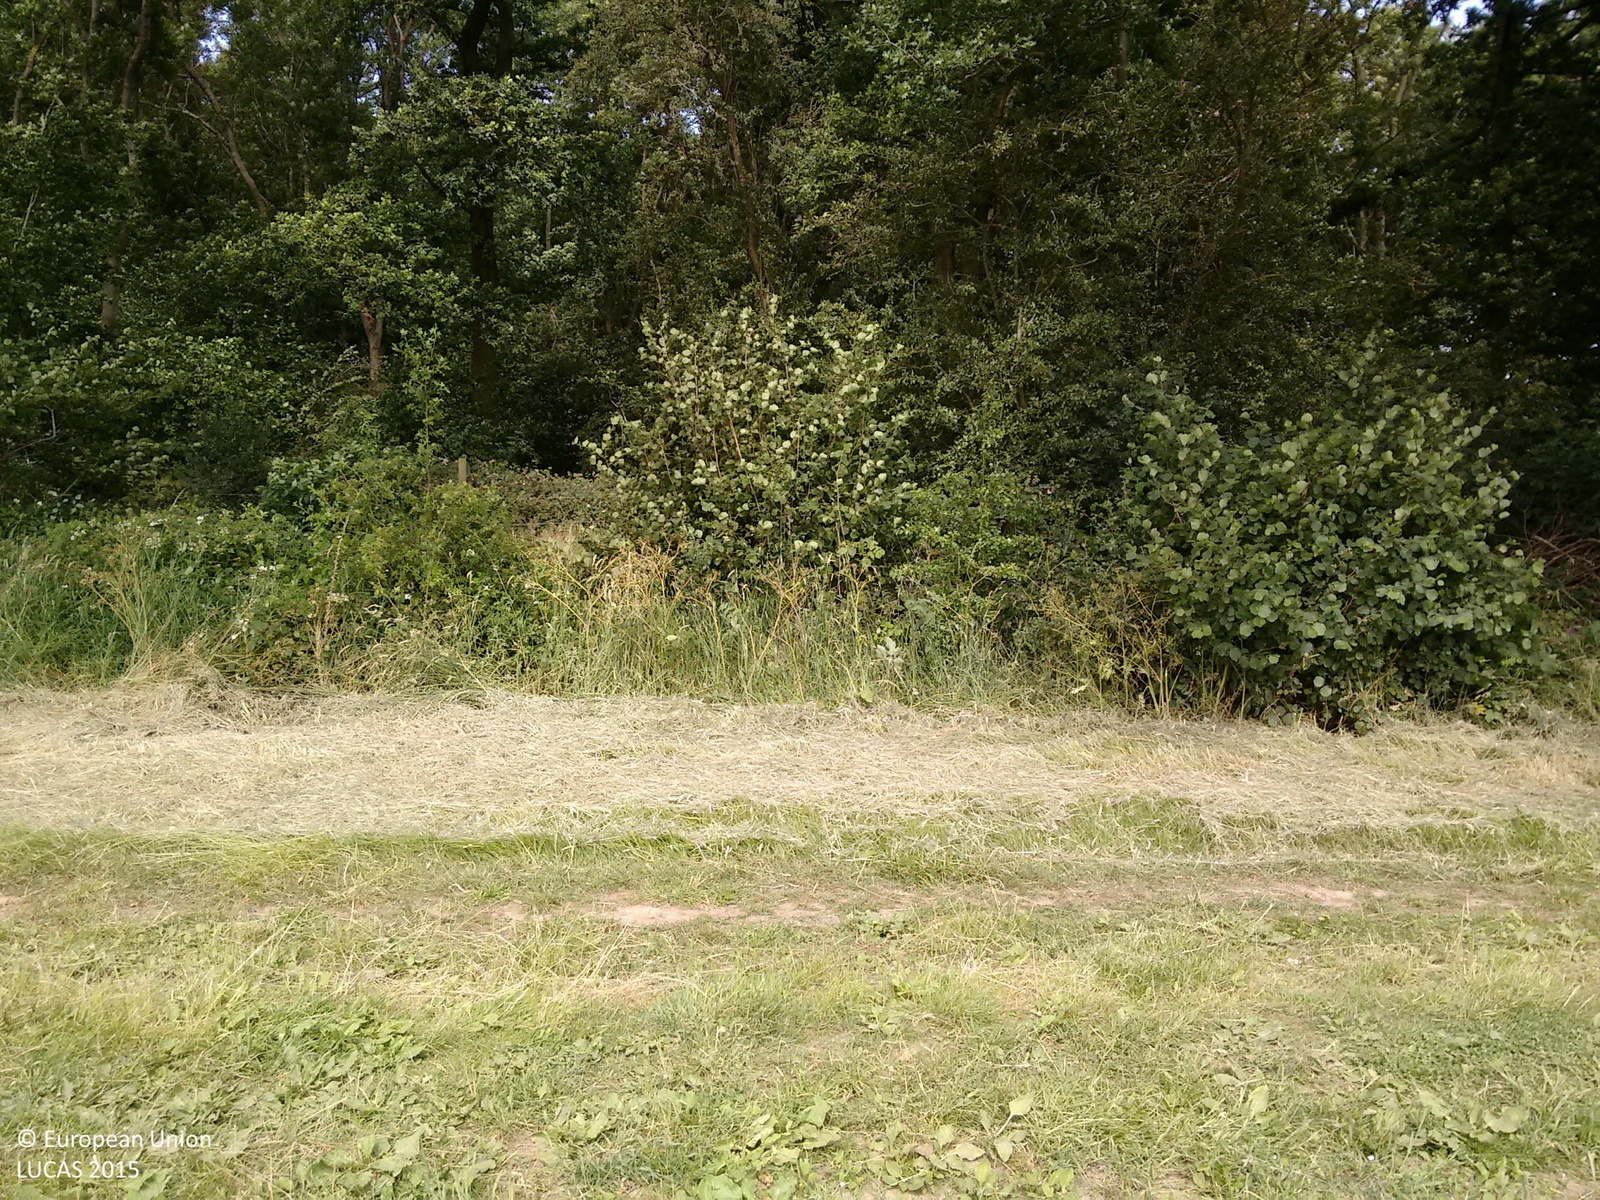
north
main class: Grassland
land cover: Grassland without tree/shrub cover
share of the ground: > 75 %
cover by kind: herbaceous plants 100 %
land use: Agriculture (excluding fallow land and kitchen gardens)
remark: Harvested field
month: July
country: GB
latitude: 53.3287
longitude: -0.8676
